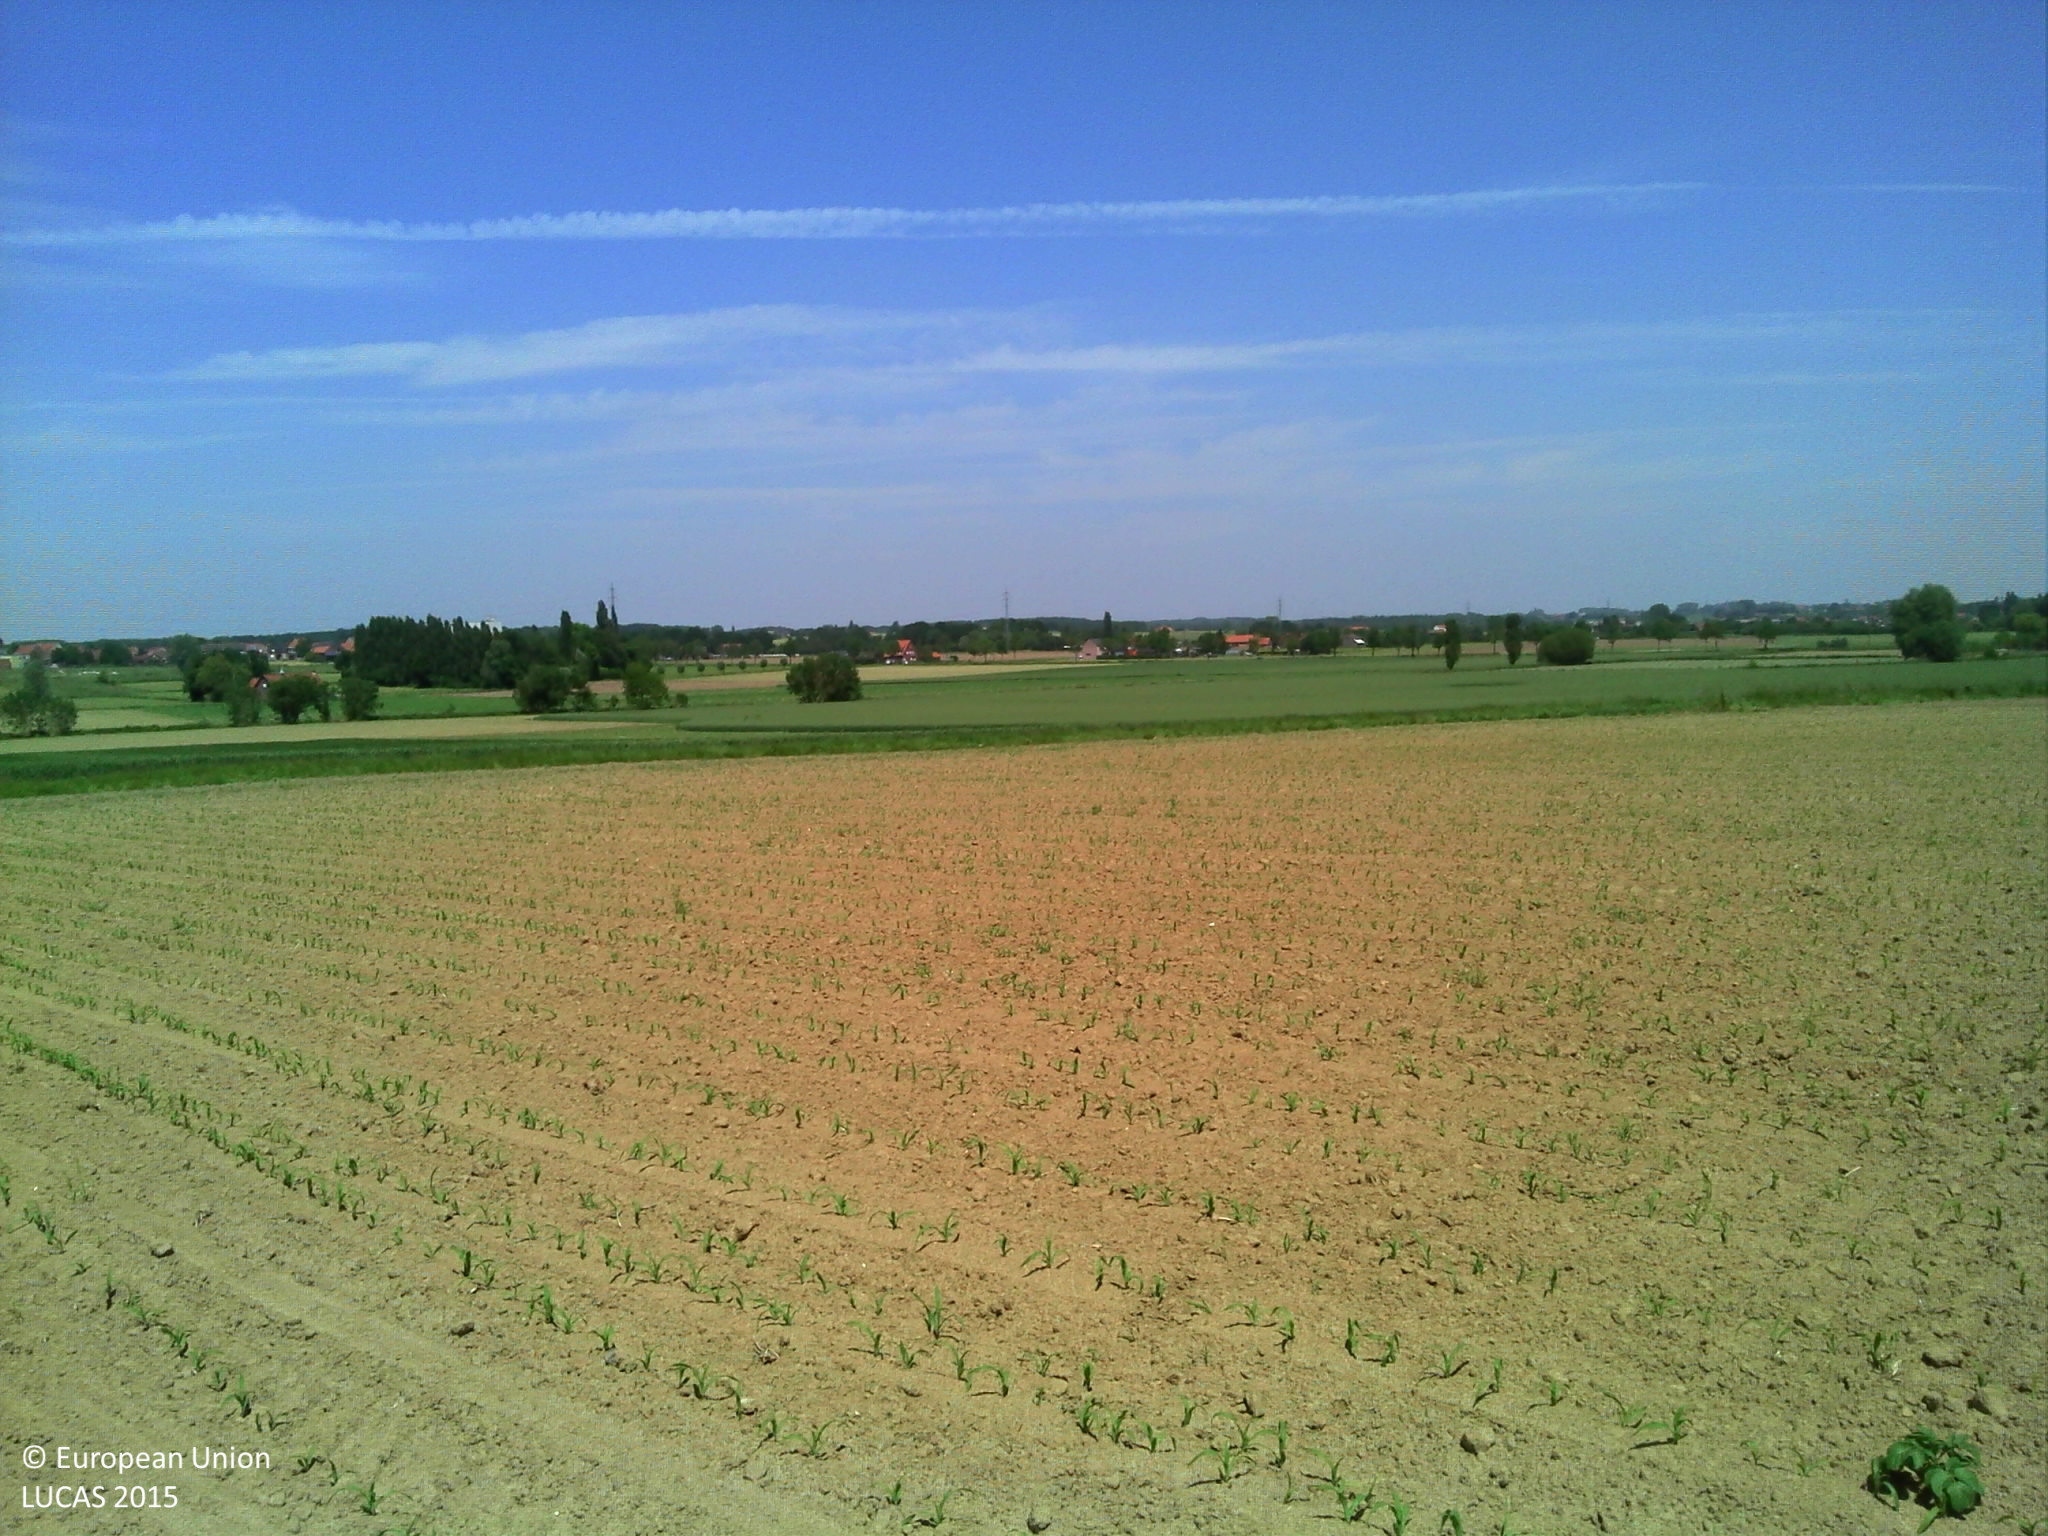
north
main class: Cropland
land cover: Maize
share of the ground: 10 - 25 %
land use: Agriculture (excluding fallow land and kitchen gardens)
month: June
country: BE
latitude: 50.7955
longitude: 2.9385
